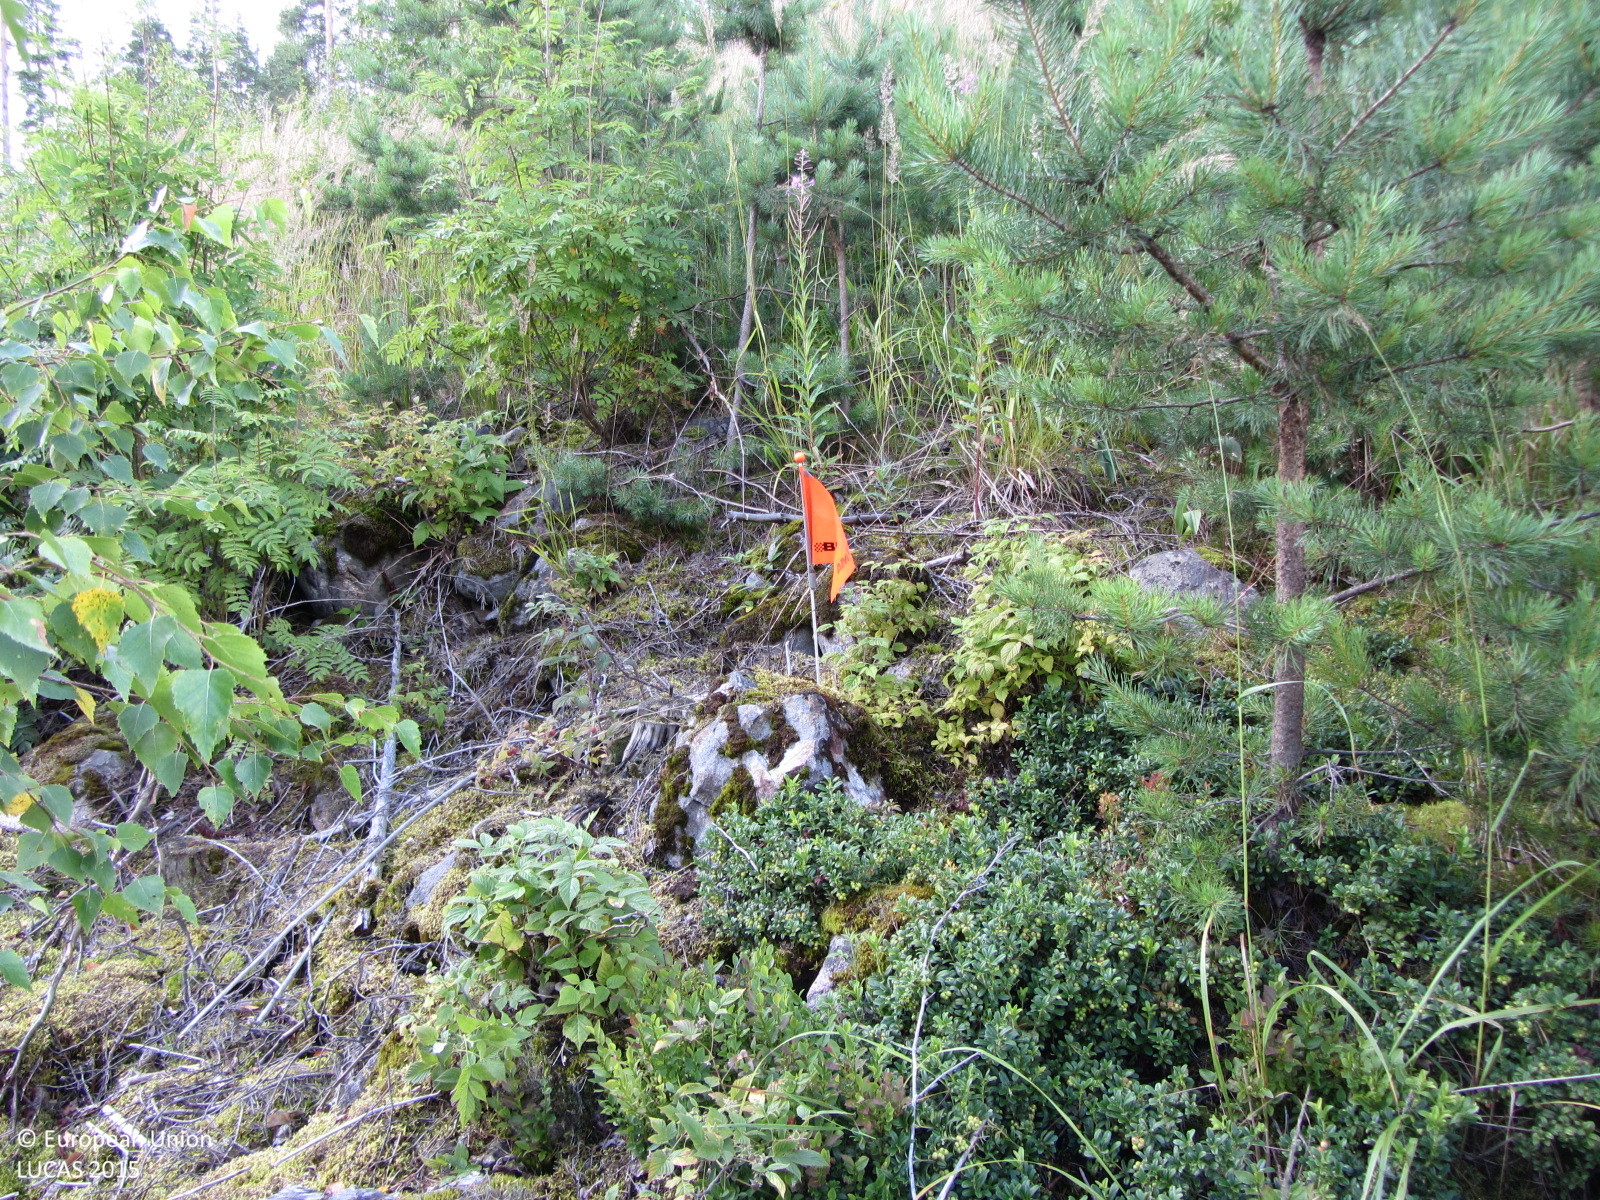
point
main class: Woodland
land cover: Pine dominated mixed woodland
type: boreal forest
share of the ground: 50 - 75 %
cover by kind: broadleaved forest trees 40 %, herbaceous plants 25 %, coniferous forest trees 20 %, lichens and mosses 10 %, consolidated bare surface 5 %
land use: Forestry
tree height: < 5 m
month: July
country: FI
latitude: 60.7283
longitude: 24.6846
